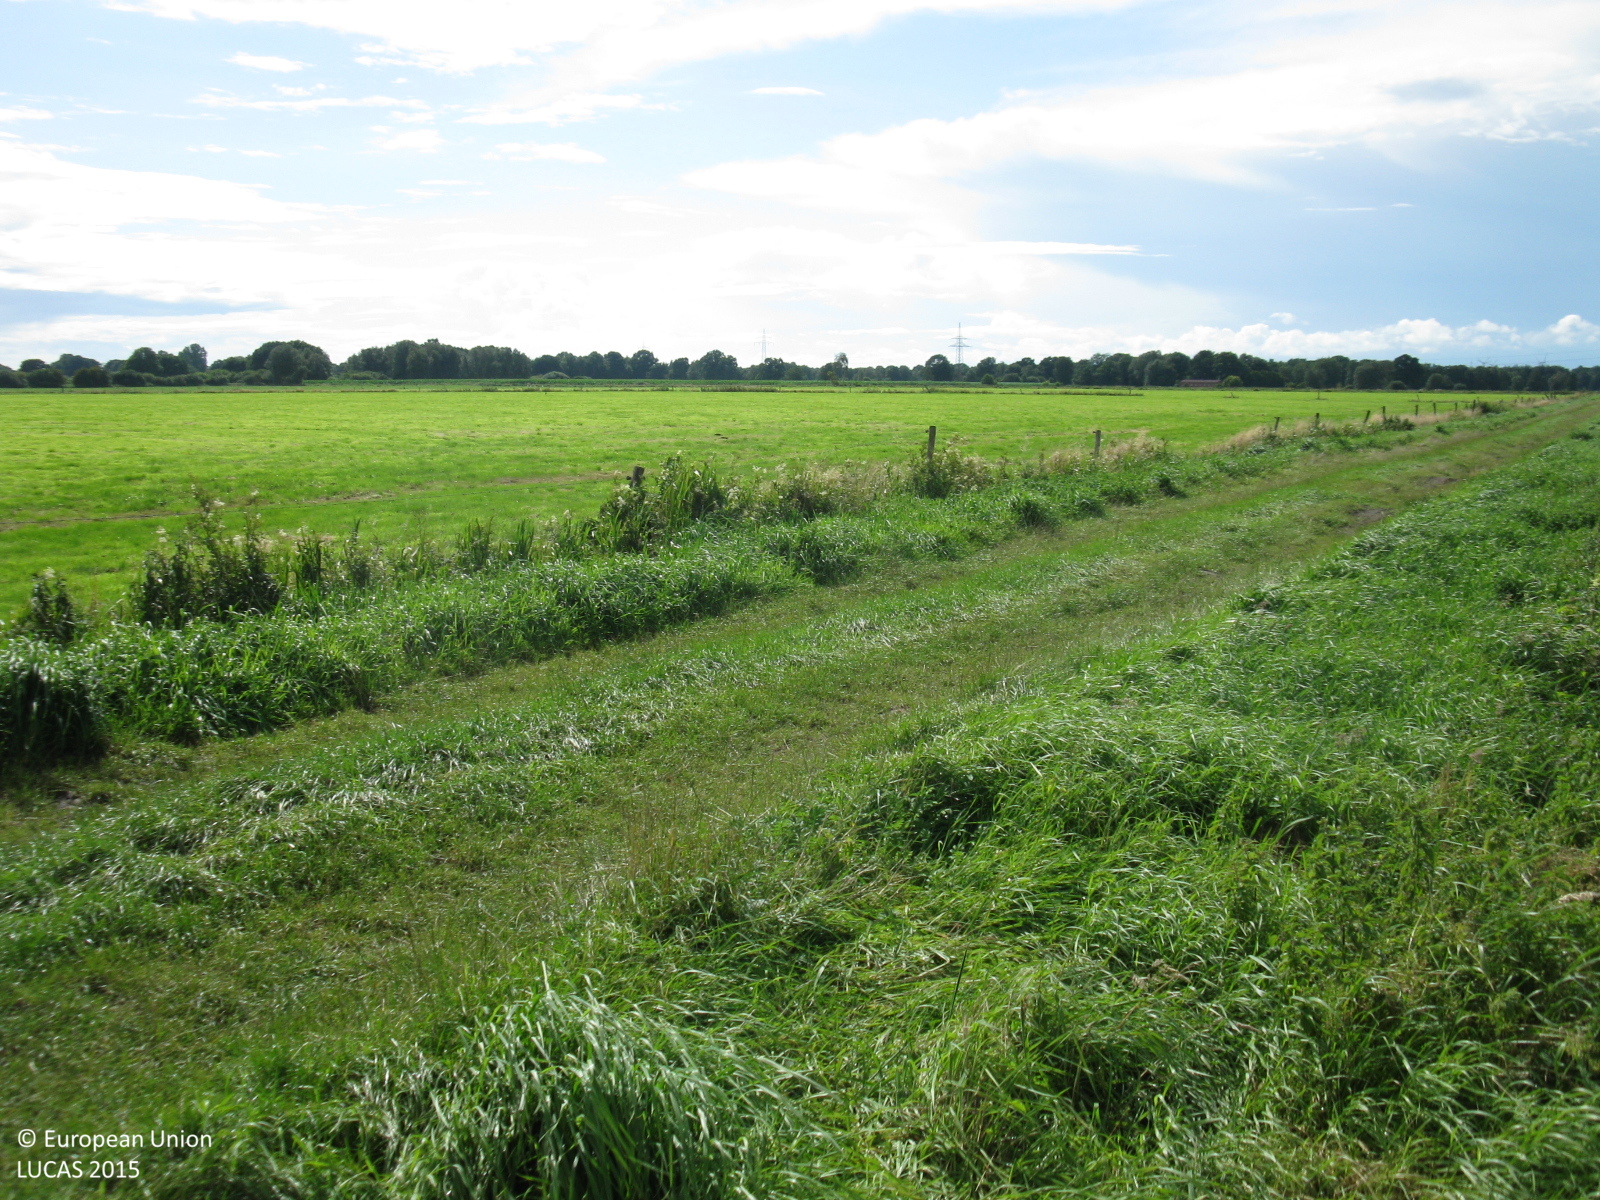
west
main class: Grassland
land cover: Grassland without tree/shrub cover
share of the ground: > 75 %
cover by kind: herbaceous plants 100 %
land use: Agriculture (excluding fallow land and kitchen gardens)
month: July
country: DE
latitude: 53.1233
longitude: 8.5212
